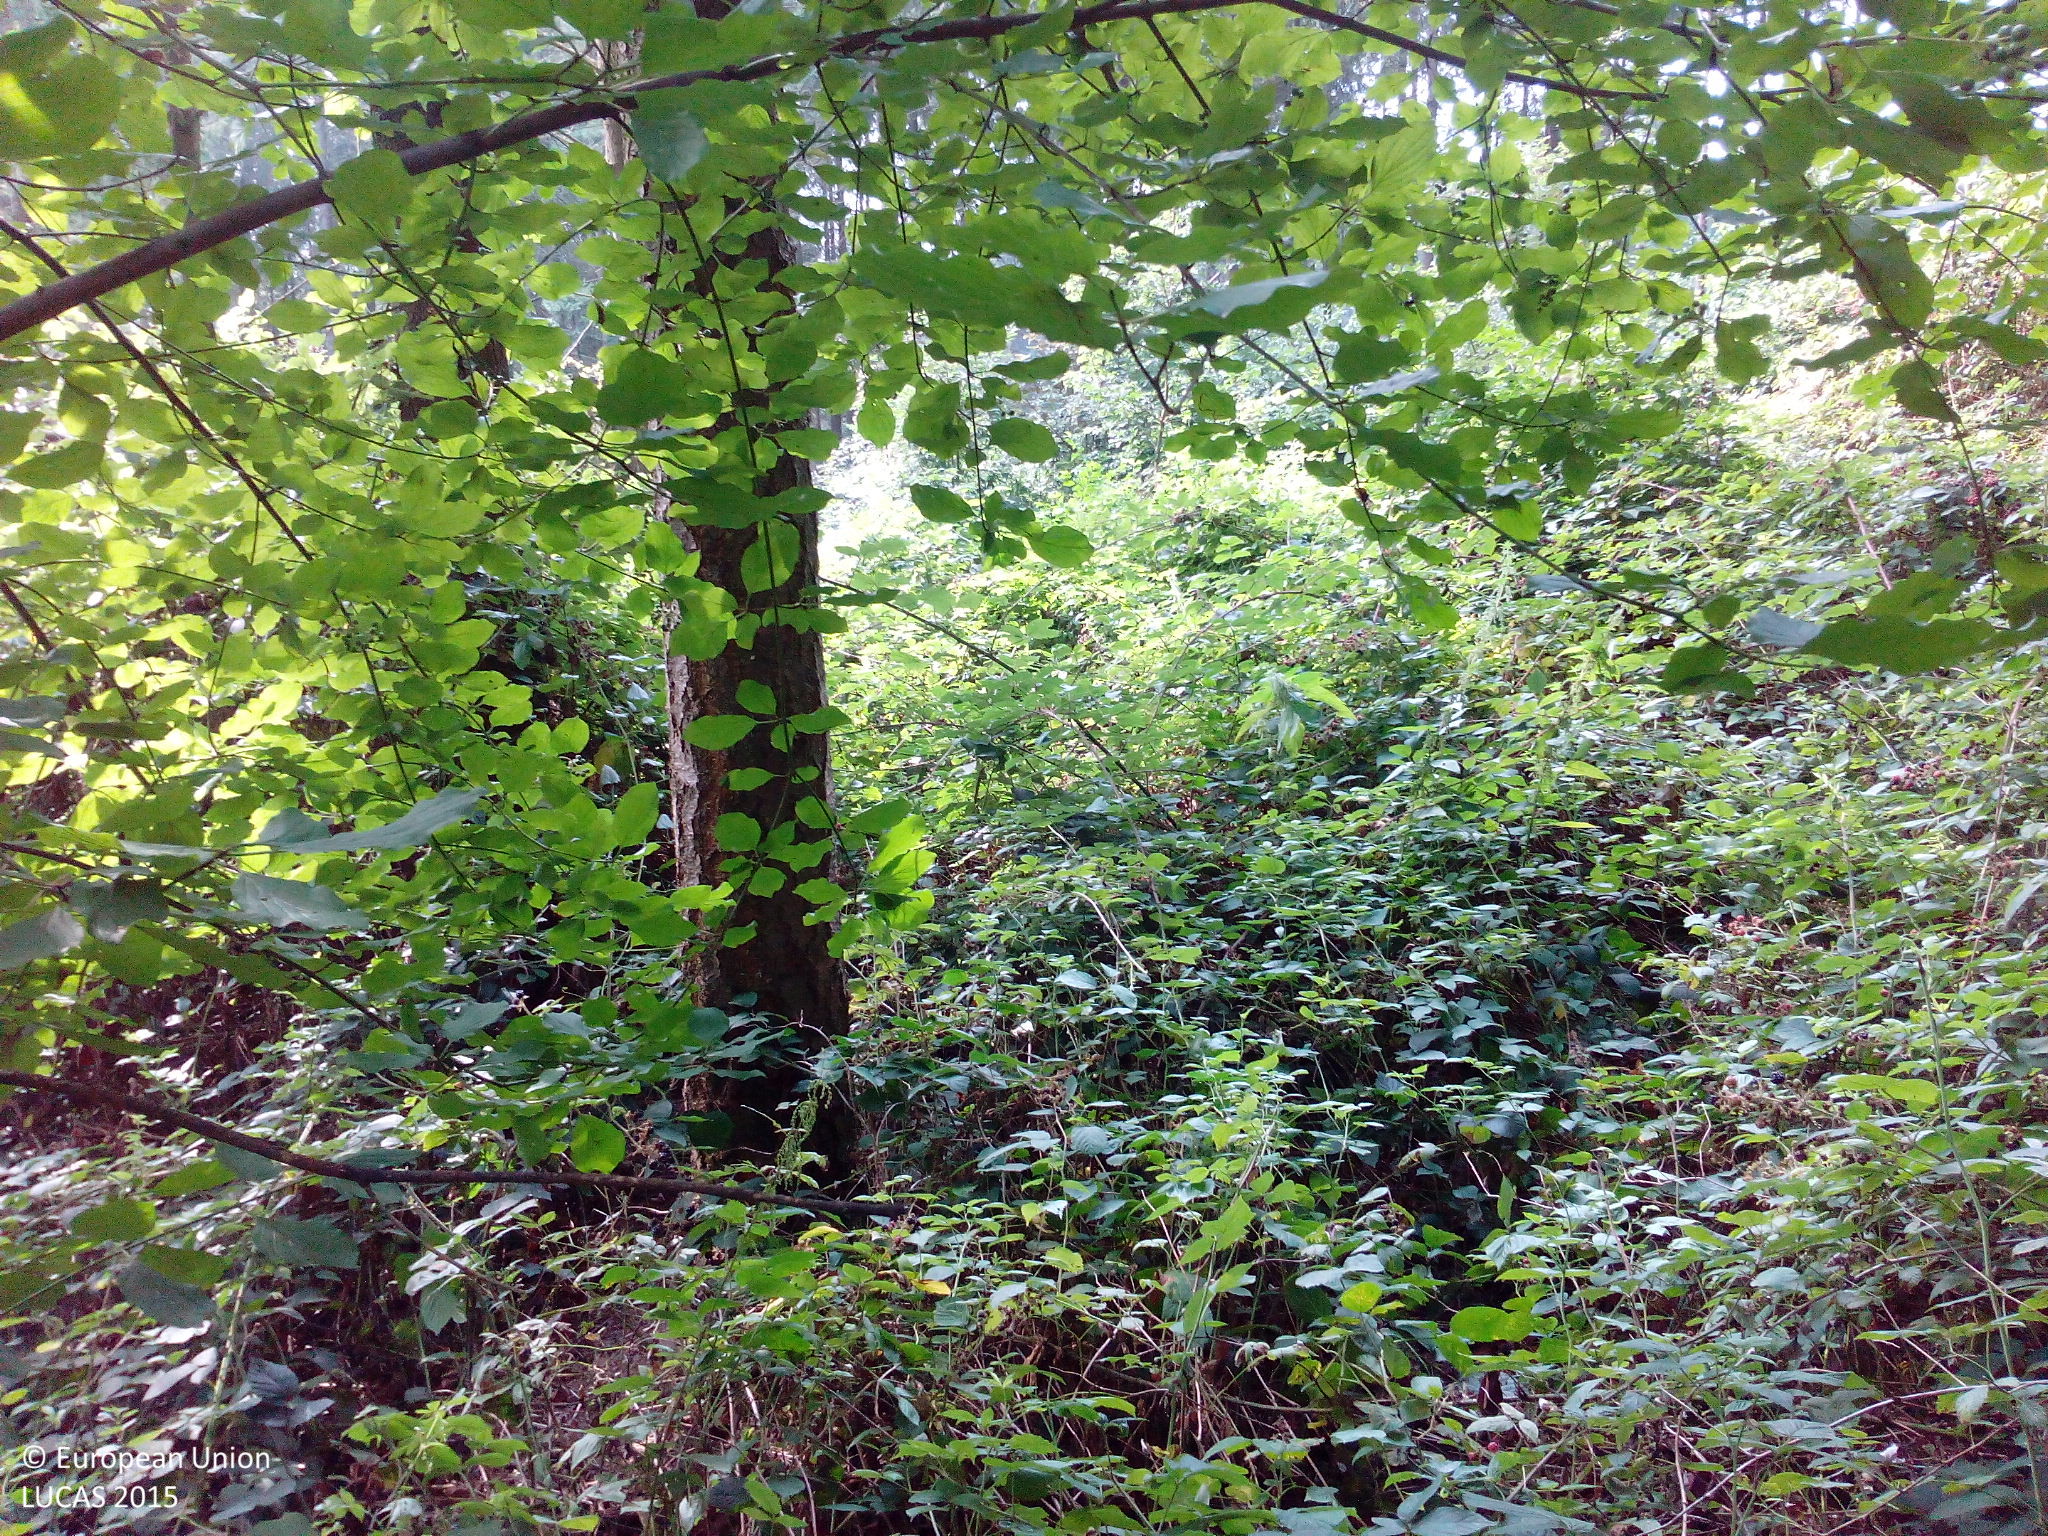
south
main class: Woodland
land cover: Spruce dominated coniferous woodland
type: hemiboreal forest and nemoral coniferous forest and mixed broadleaved-coniferous forest
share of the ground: 50 - 75 %
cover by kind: coniferous forest trees 65 %, shrubs 20 %, broadleaved forest trees 10 %, unconsolidated bare surface 5 %
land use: Forestry
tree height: > 5 m
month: August
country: DE
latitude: 50.3358
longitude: 7.4573
